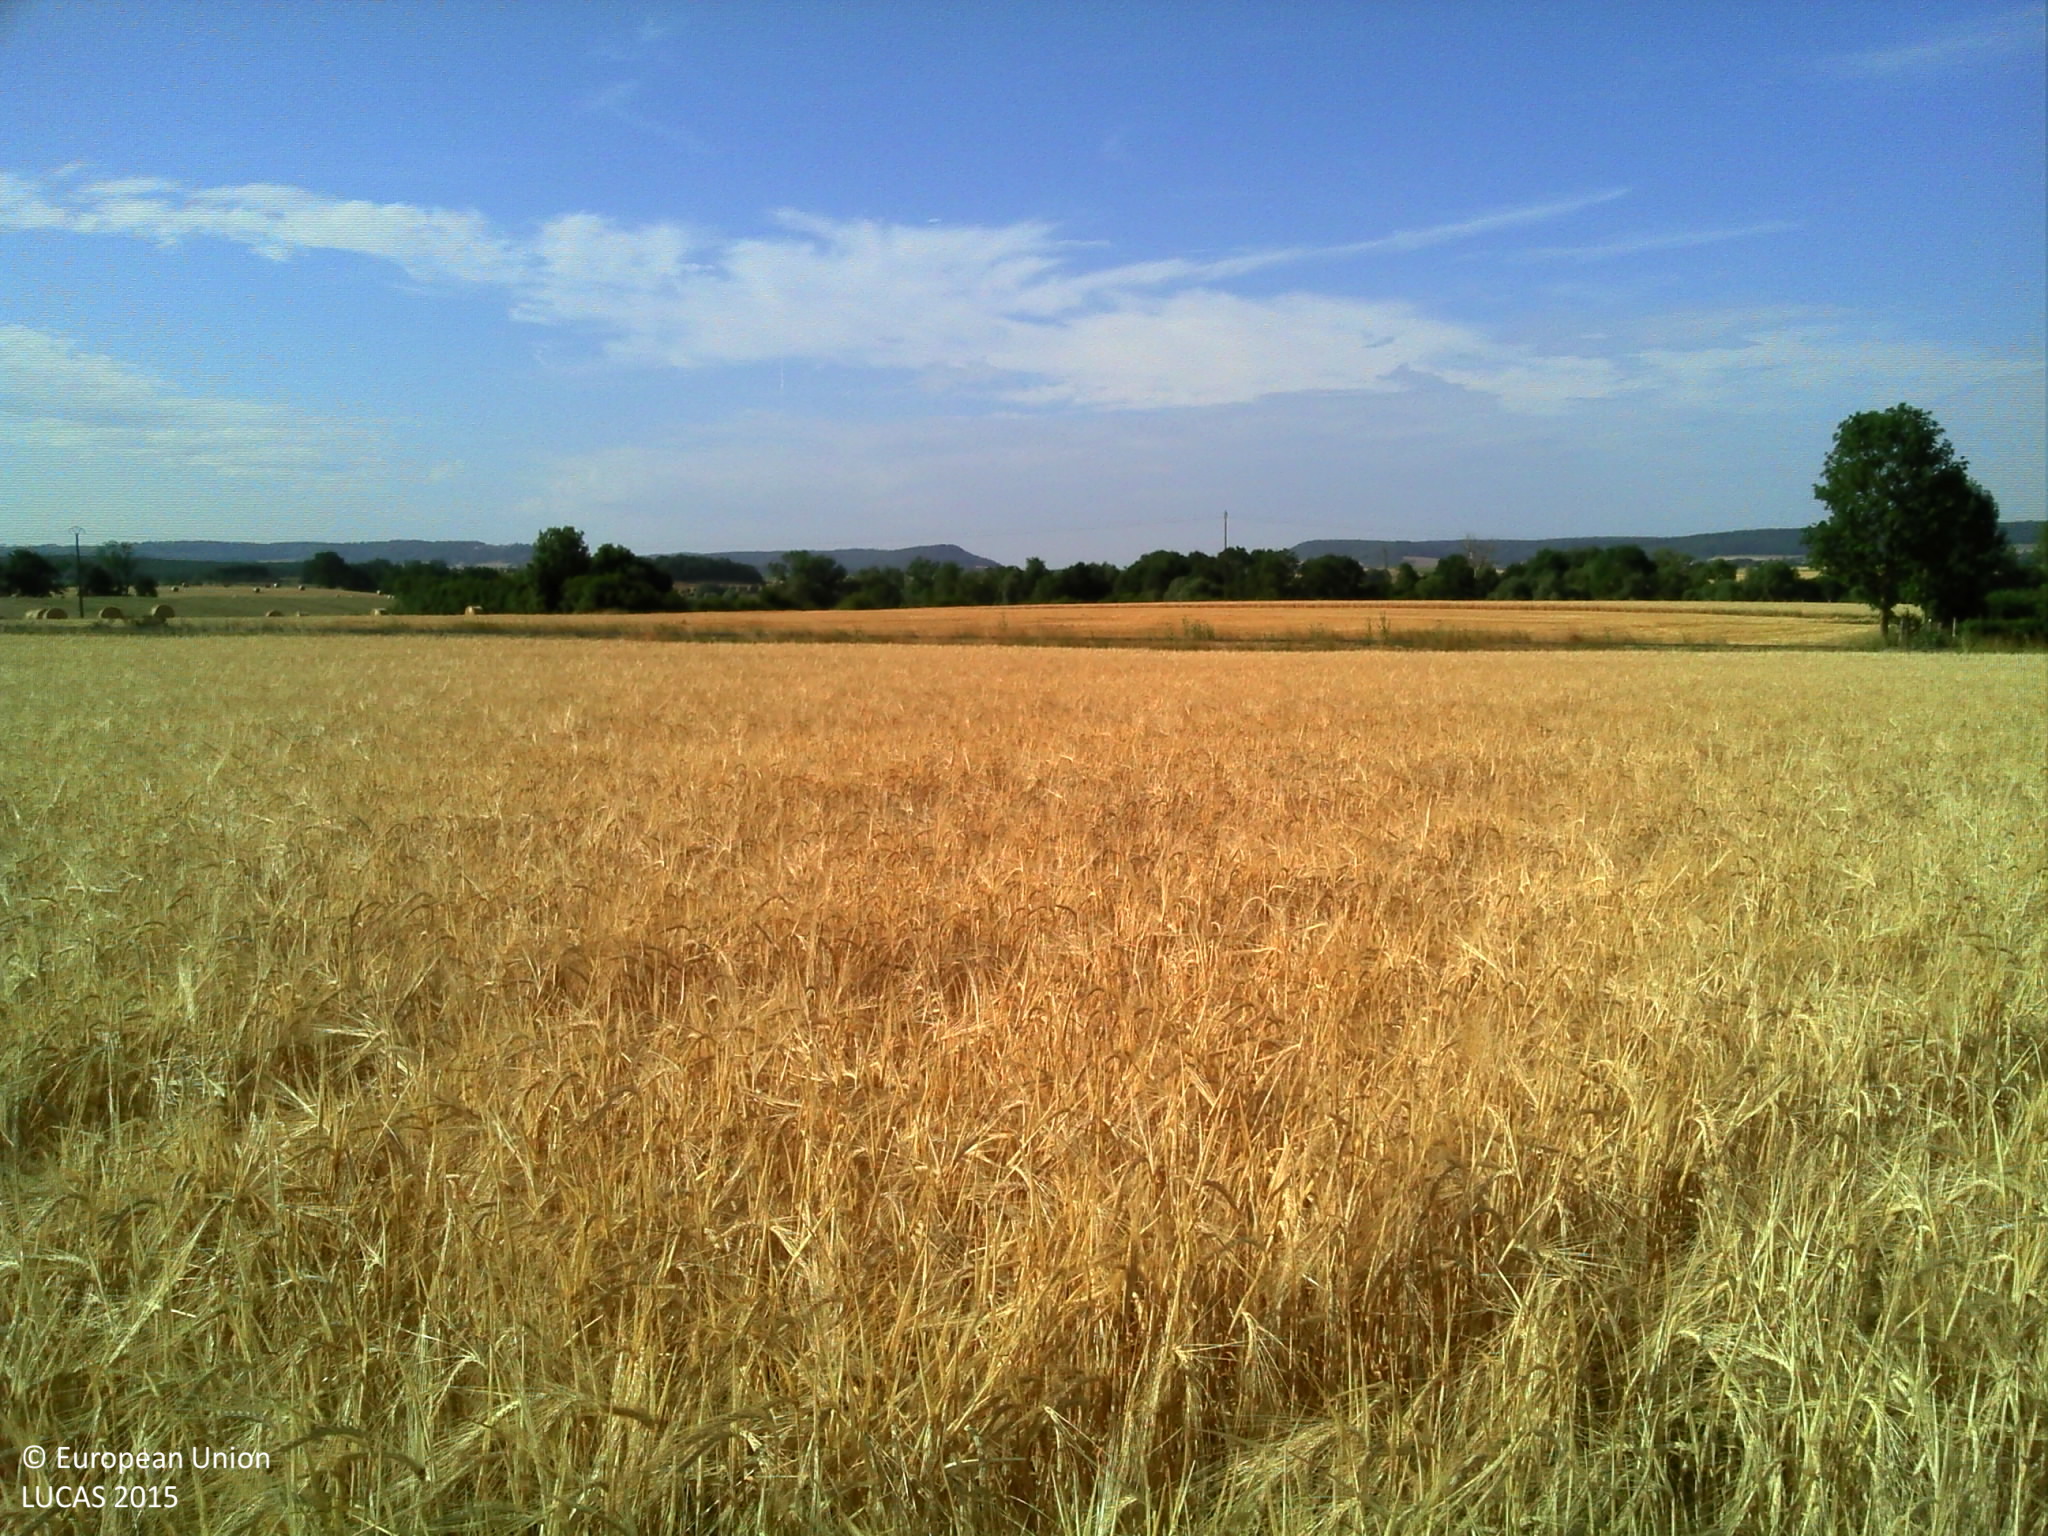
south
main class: Cropland
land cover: Barley
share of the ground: > 75 %
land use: Agriculture (excluding fallow land and kitchen gardens)
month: July
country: FR
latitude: 48.4946
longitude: 6.0351
